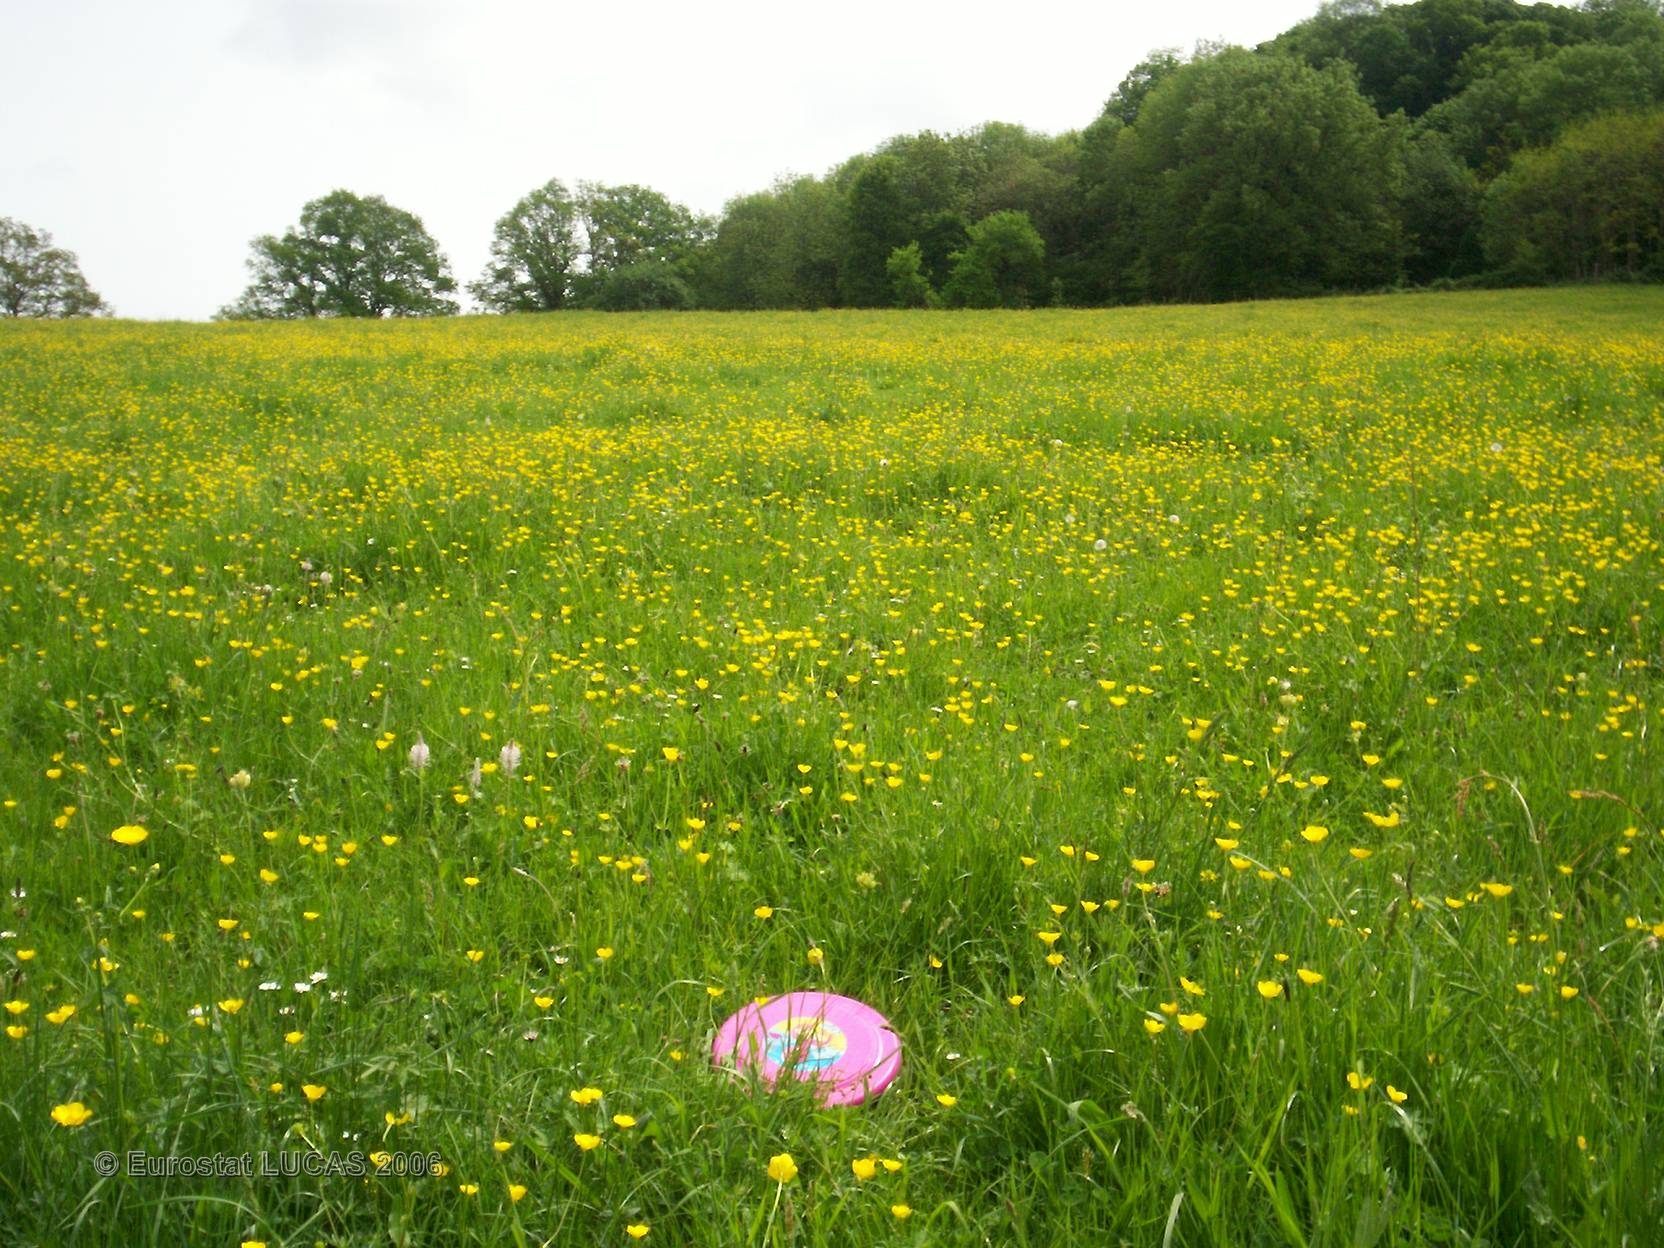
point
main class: Grassland
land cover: Grassland without tree/shrub cover
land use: Agriculture (excluding fallow land and kitchen gardens)
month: May
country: FR
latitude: 47.3137
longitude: 4.5627
